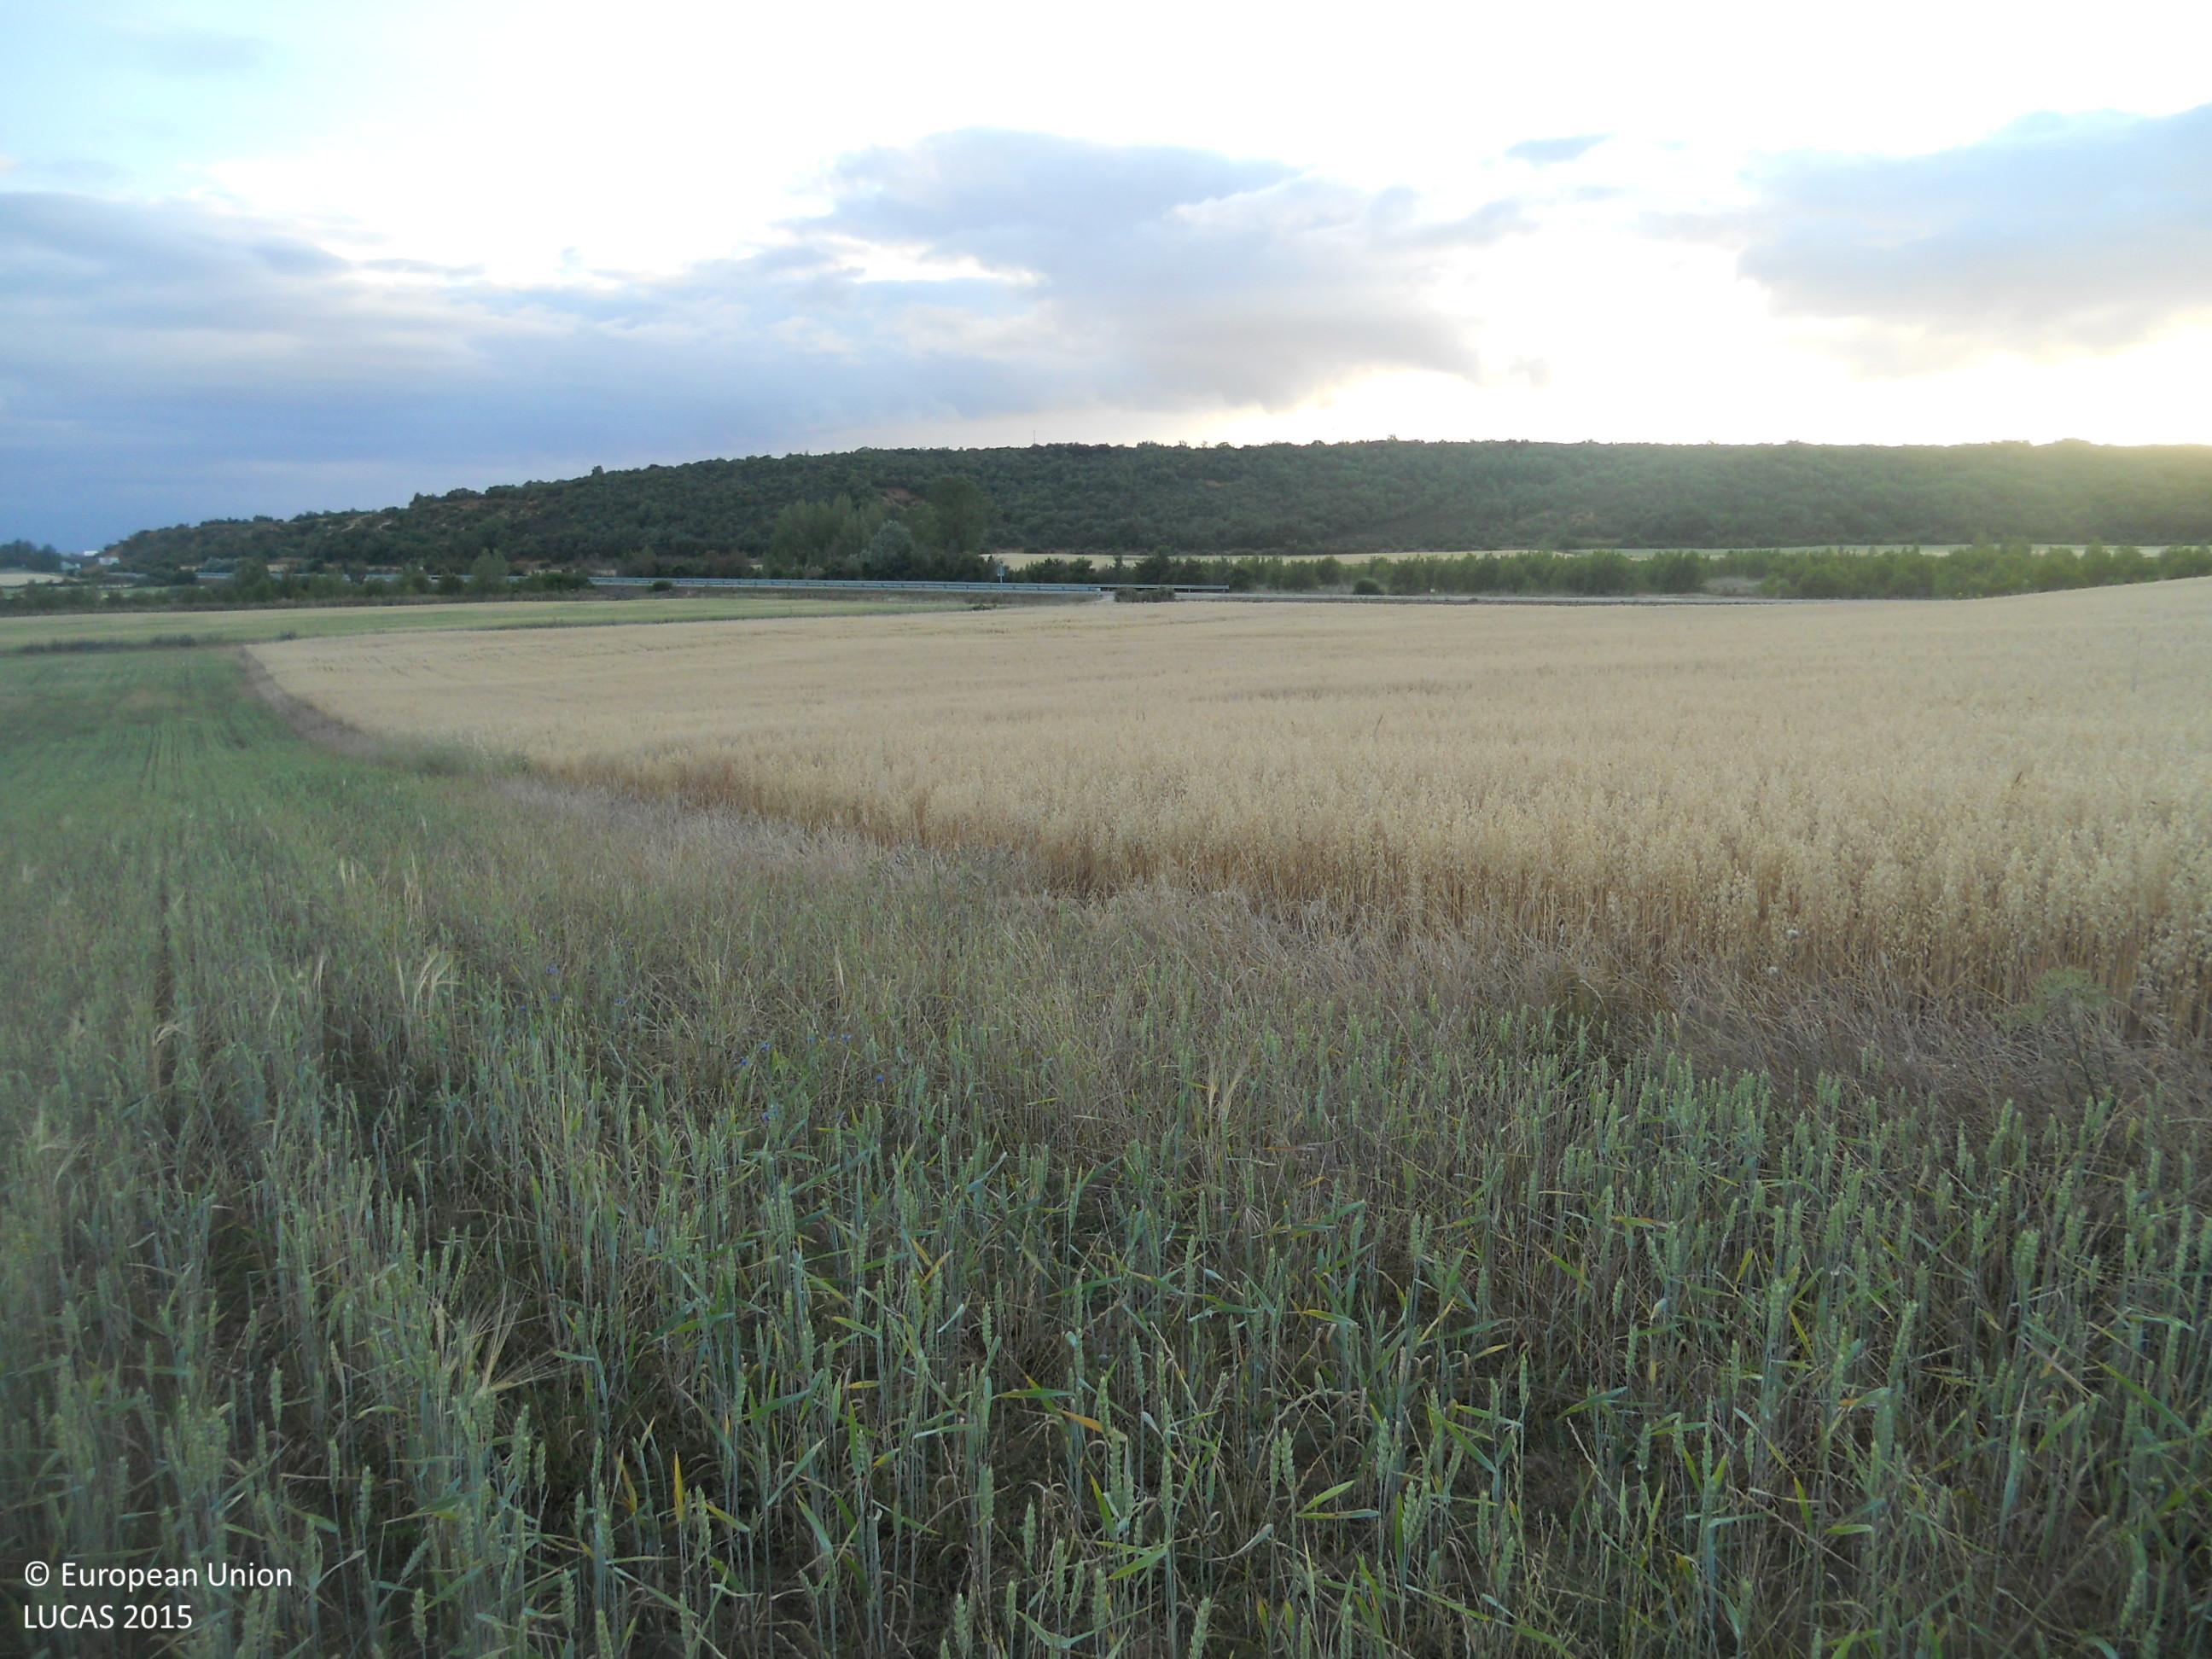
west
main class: Cropland
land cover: Common wheat
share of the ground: > 75 %
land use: Agriculture (excluding fallow land and kitchen gardens)
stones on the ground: < 10 %
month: June
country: ES
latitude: 42.3757
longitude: -4.8603
